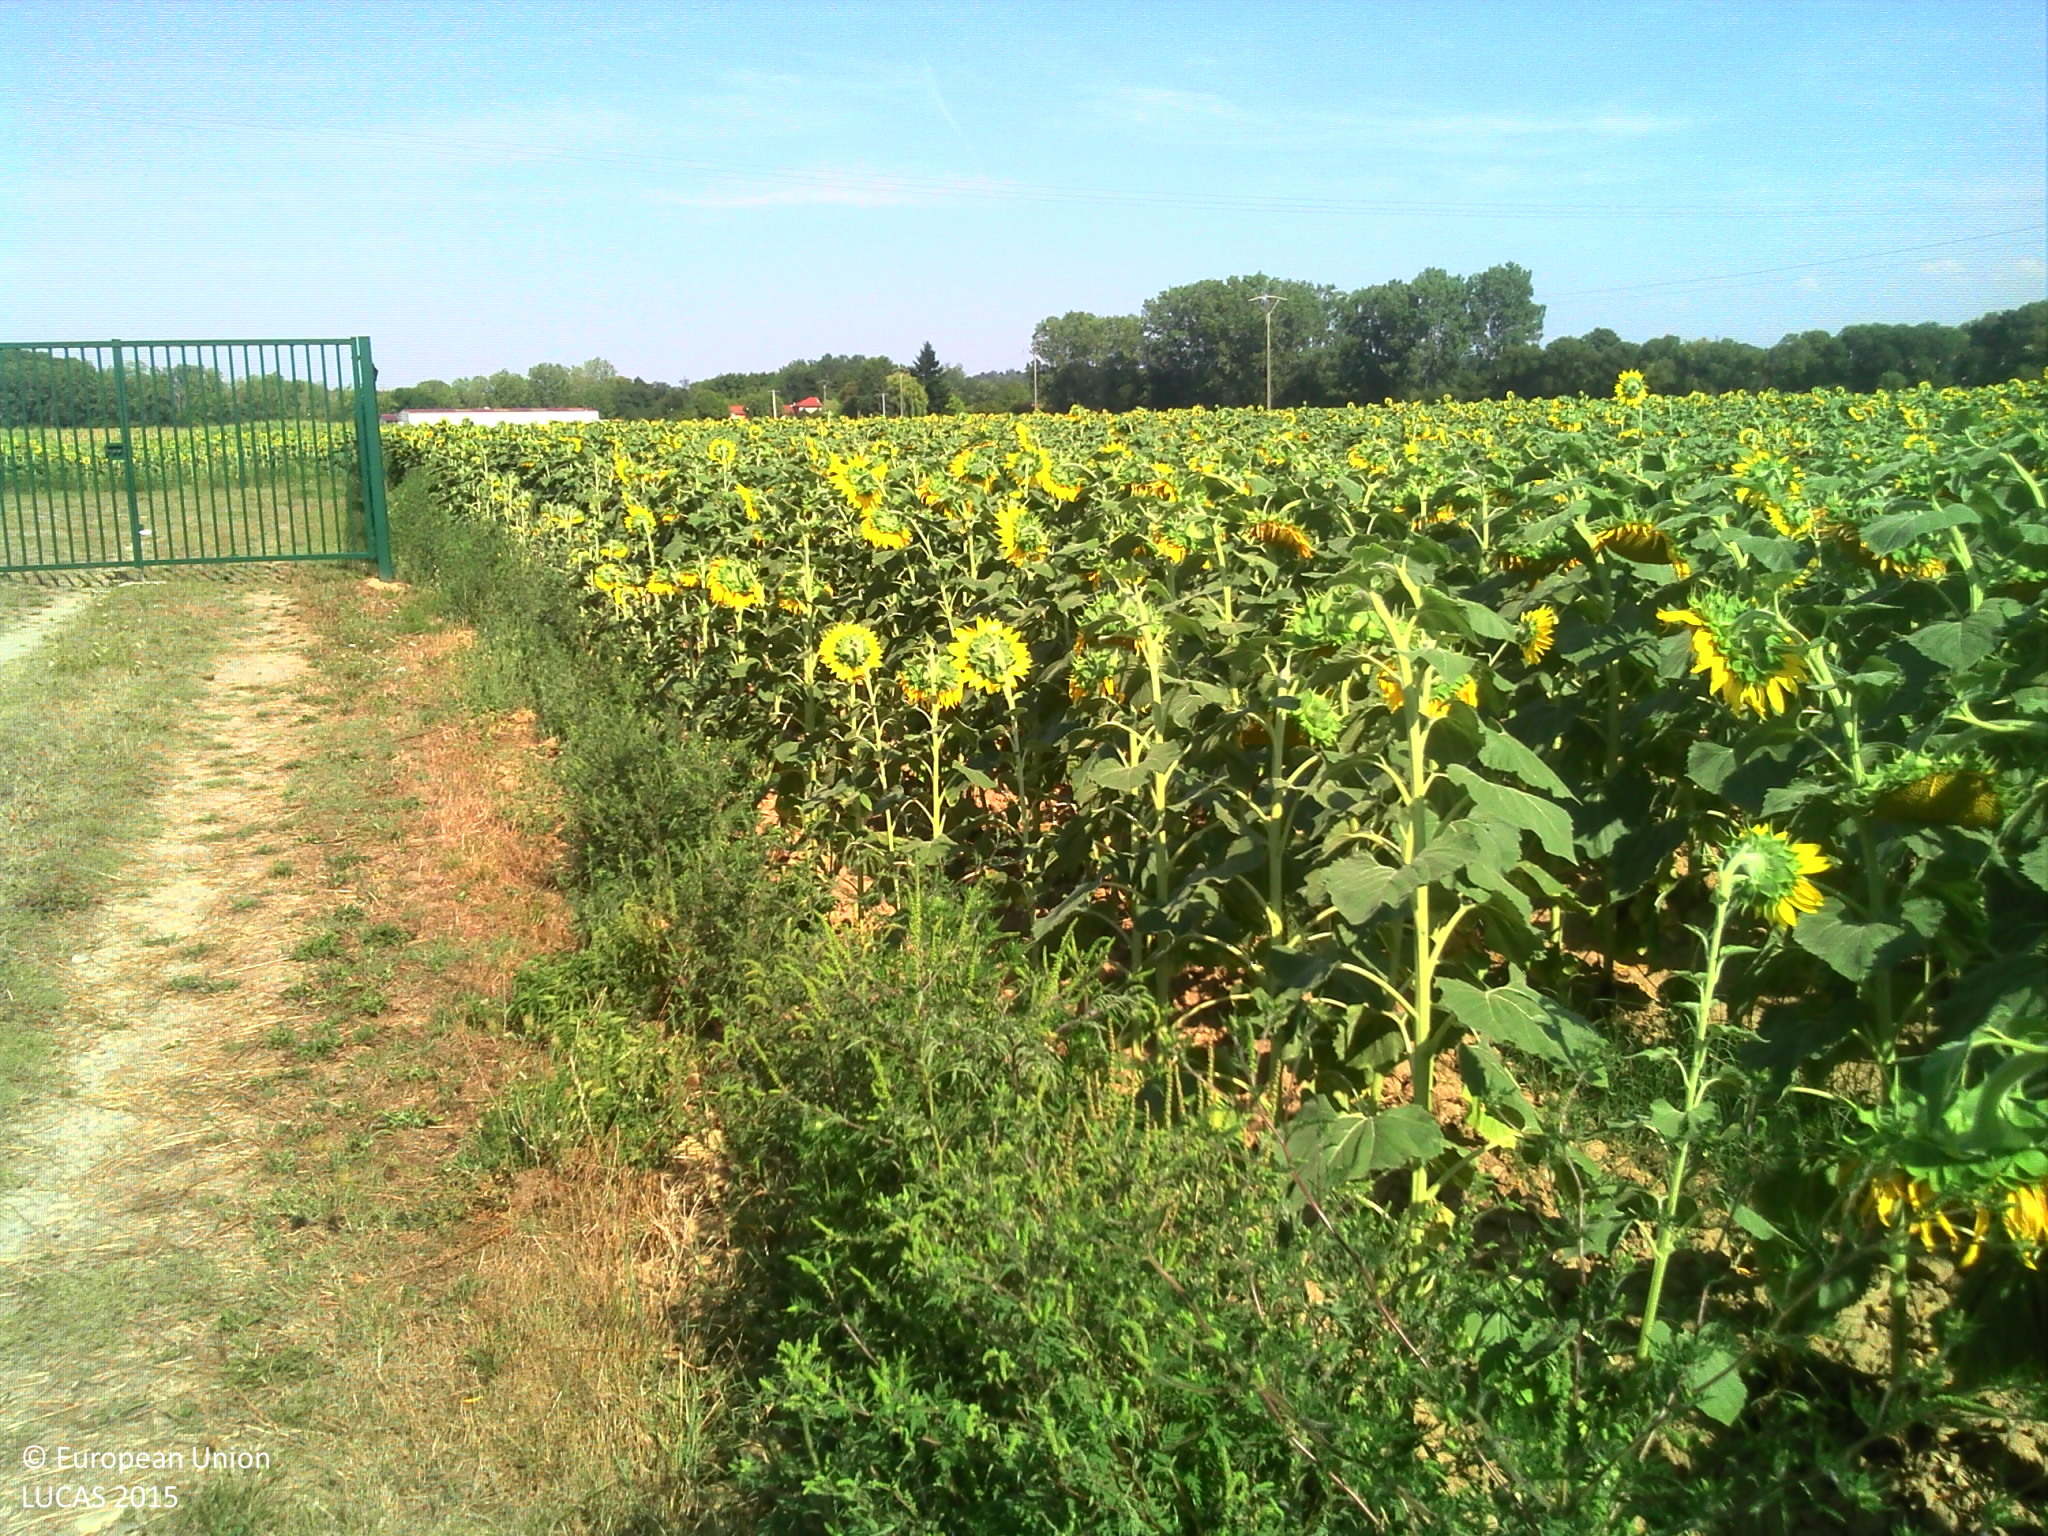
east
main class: Cropland
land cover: Sunflower
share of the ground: > 75 %
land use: Agriculture (excluding fallow land and kitchen gardens)
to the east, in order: Sunflower; Maize
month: August
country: FR
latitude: 45.6345
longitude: 4.9111
